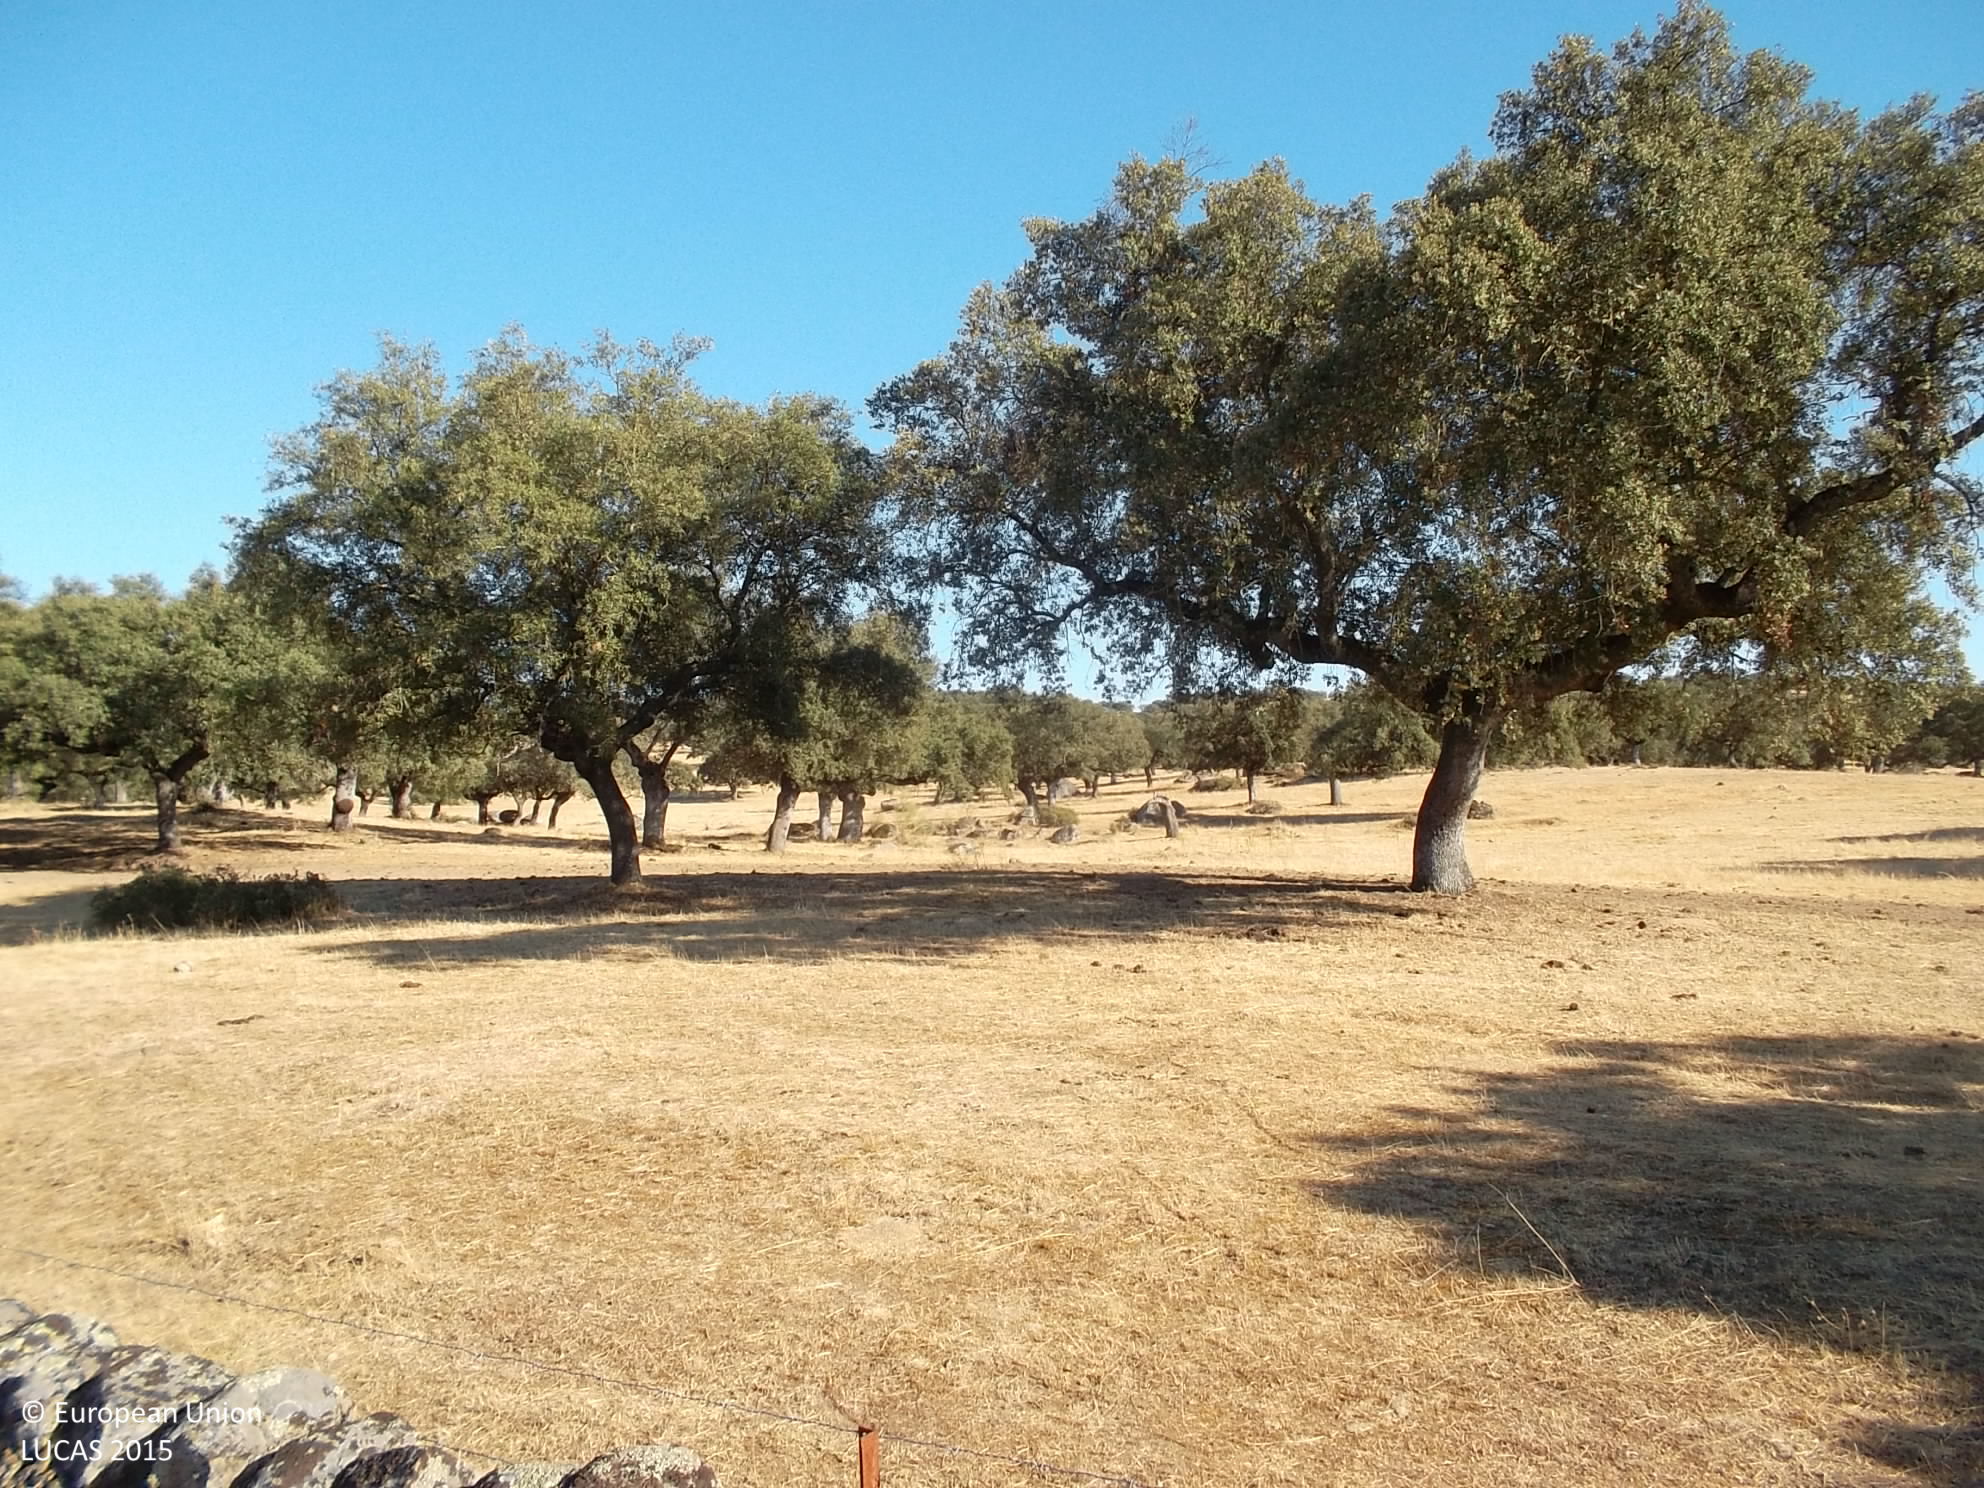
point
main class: Woodland
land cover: Broadleaved woodland
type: broadleaved evergreen forest
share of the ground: 25 - 50 %
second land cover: Grassland without tree/shrub cover
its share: > 75 %
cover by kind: herbaceous plants 75 %, broadleaved forest trees 25 %
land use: Forestry
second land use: Agriculture (excluding fallow land and kitchen gardens)
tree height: > 5 m
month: August
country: ES
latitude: 38.3526
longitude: -6.6576
